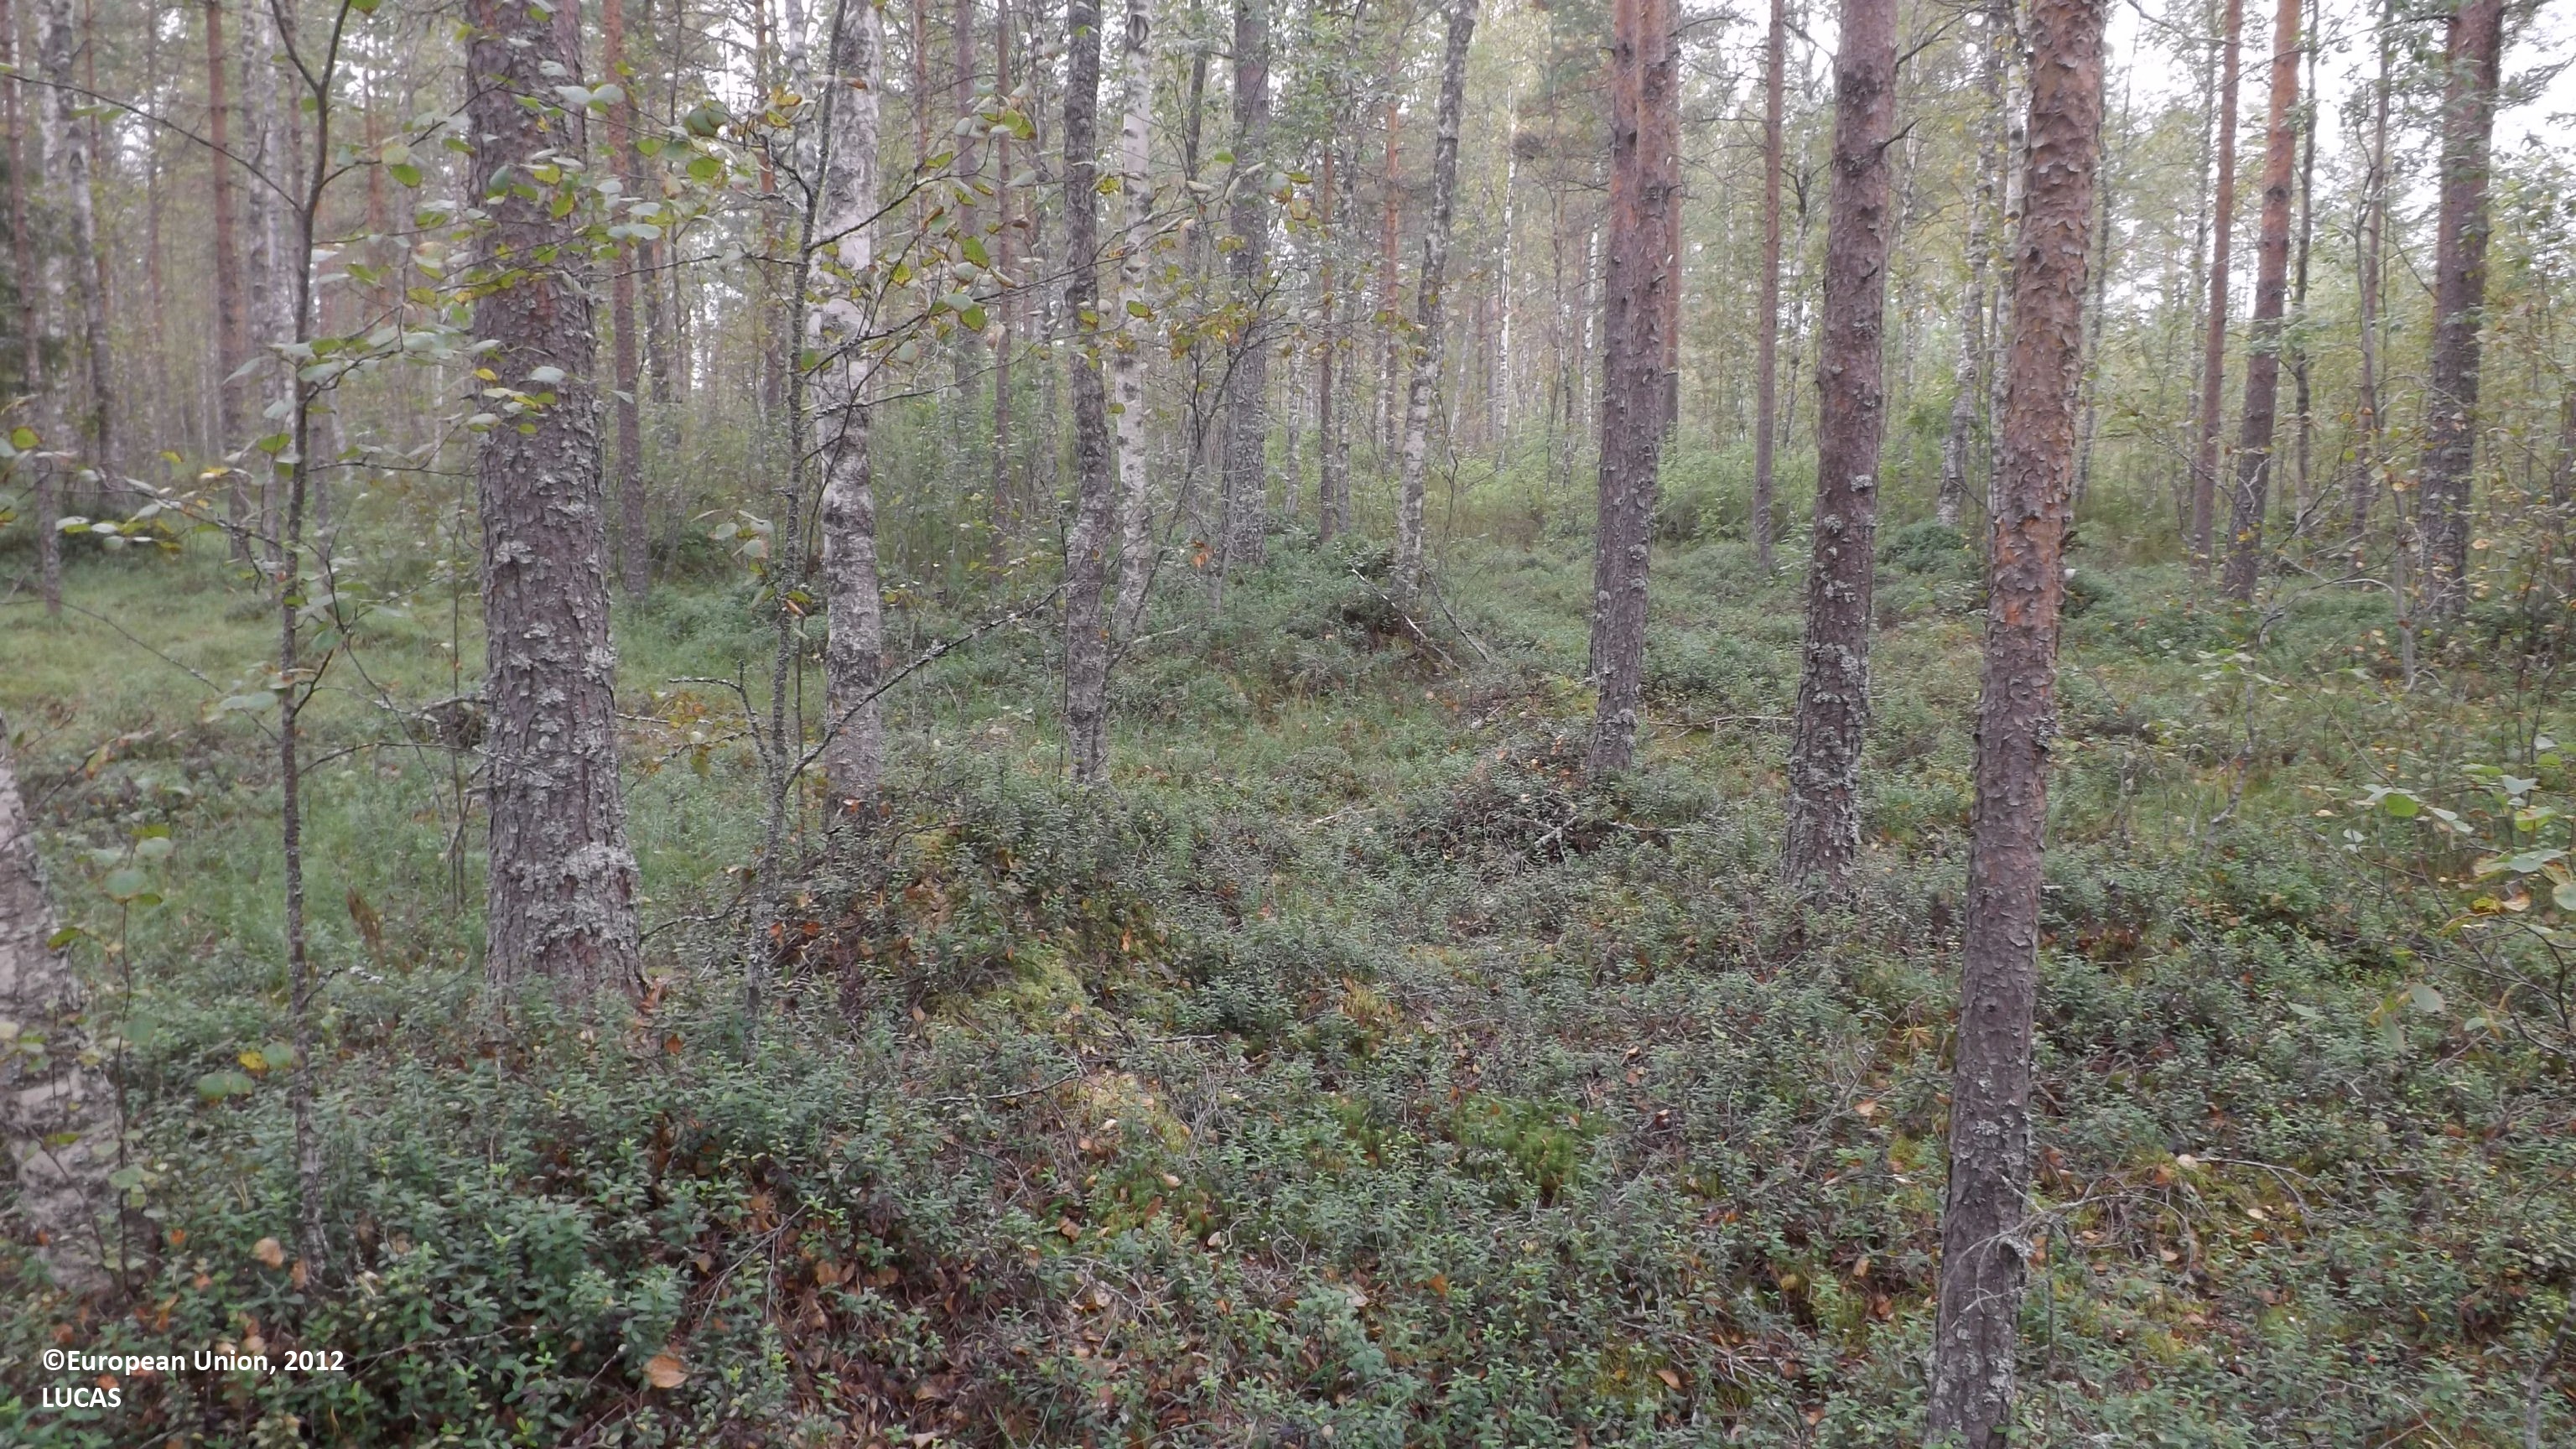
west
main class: Woodland
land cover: Pine dominated mixed woodland
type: boreal forest
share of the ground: > 75 %
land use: Forestry
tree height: > 5 m
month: August
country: FI
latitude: 63.8758
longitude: 23.8861
